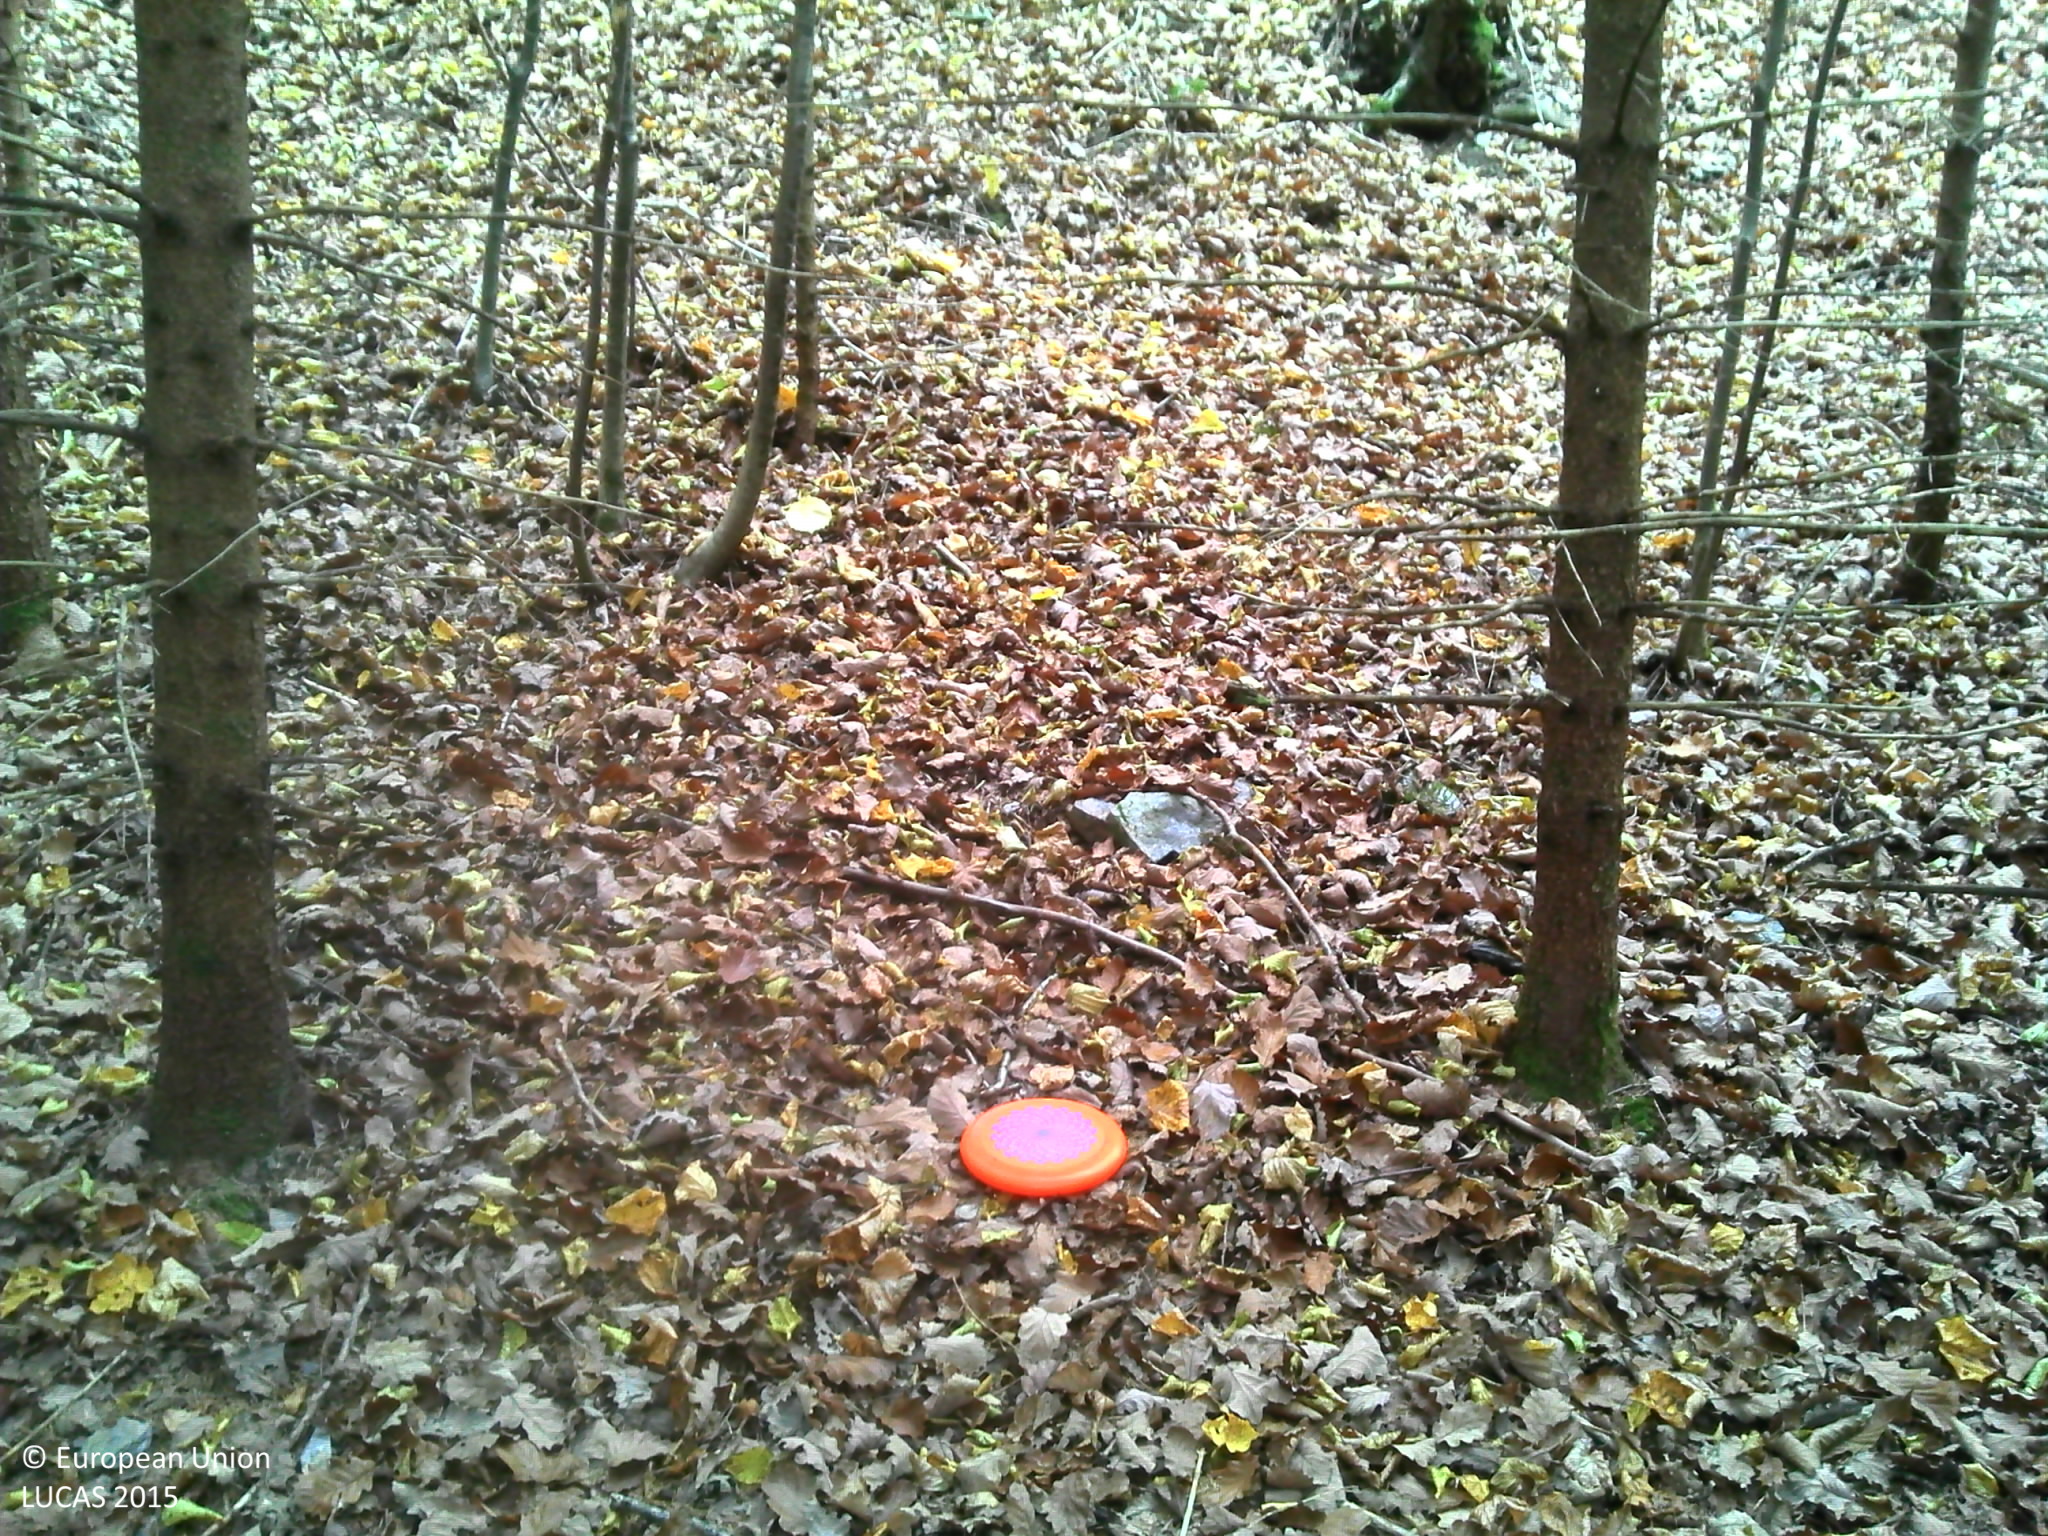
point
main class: Woodland
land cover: Spruce dominated mixed woodland
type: hemiboreal forest and nemoral coniferous forest and mixed broadleaved-coniferous forest
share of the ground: > 75 %
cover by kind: coniferous forest trees 50 %, broadleaved forest trees 40 %, consolidated bare surface 10 %
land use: Forestry
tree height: > 5 m
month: November
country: FR
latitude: 45.7160
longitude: 6.4713
